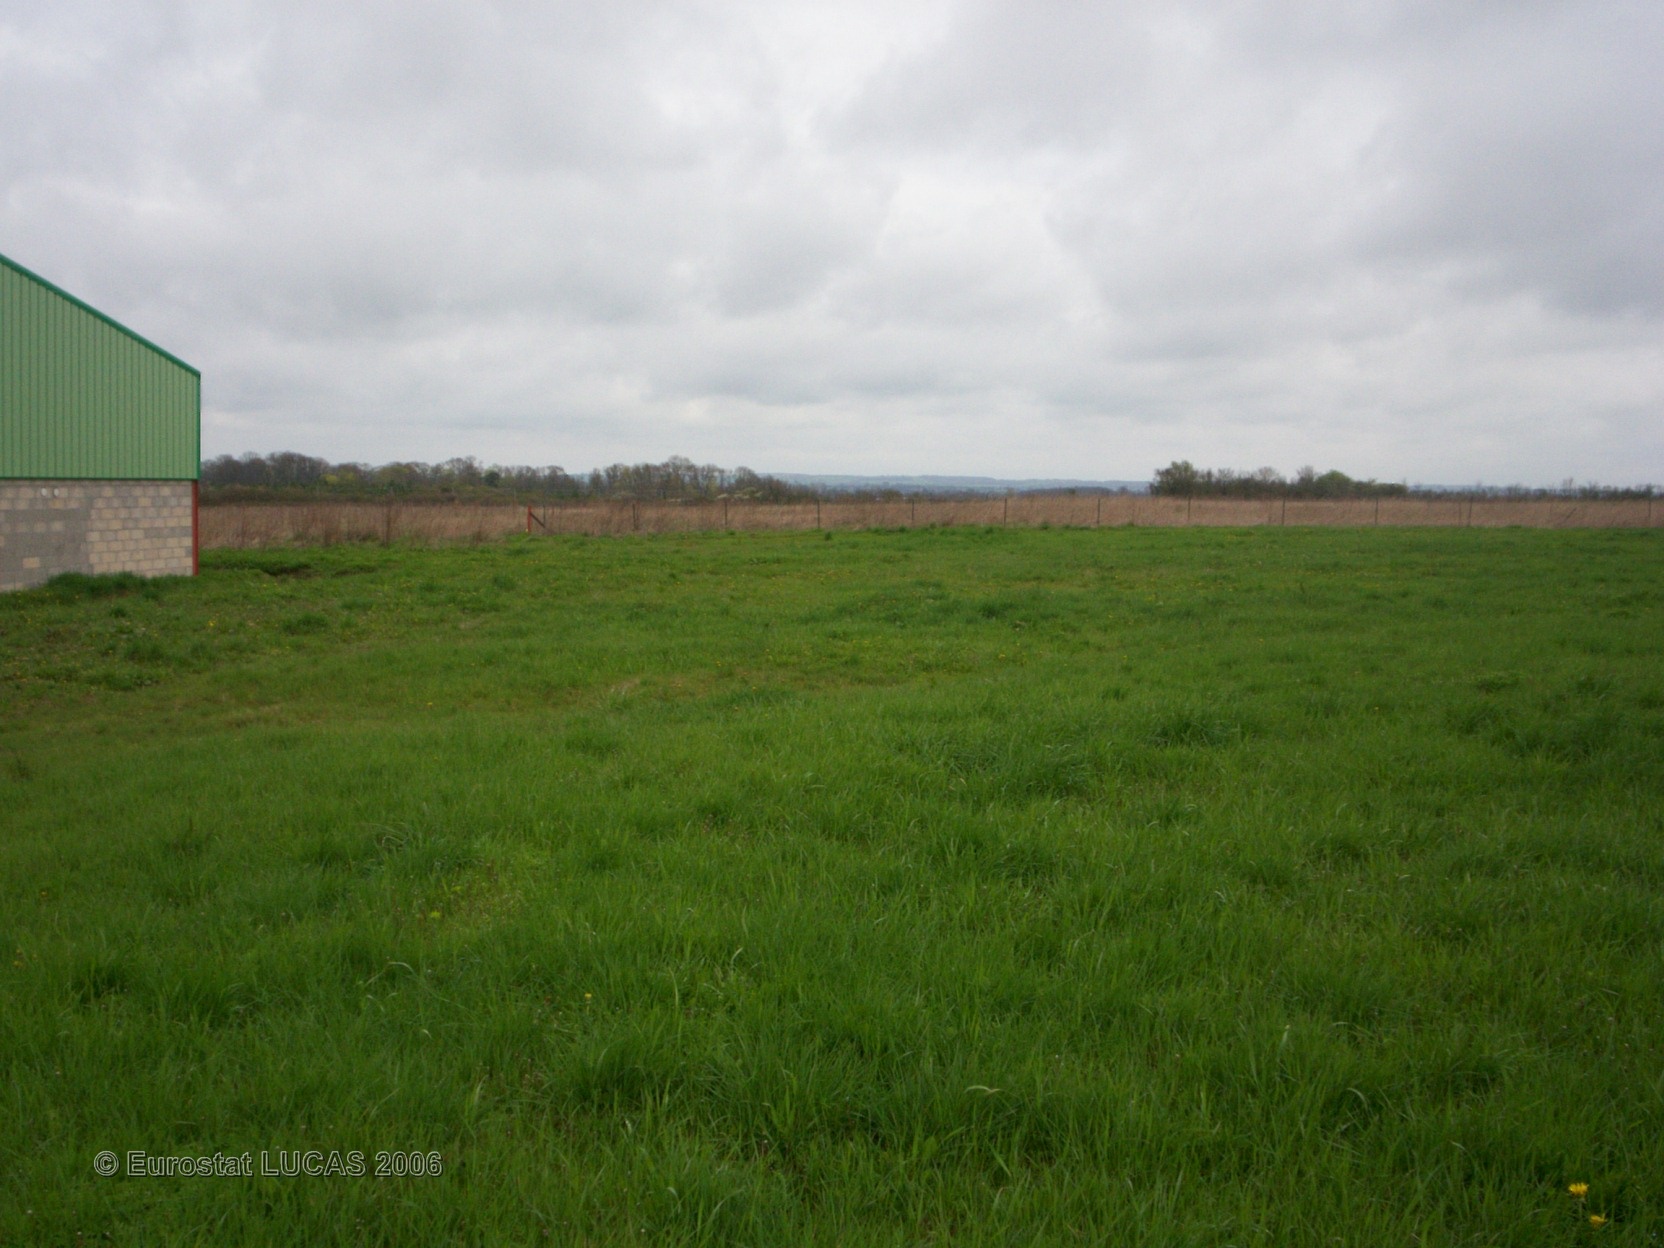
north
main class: Grassland
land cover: Grassland without tree/shrub cover
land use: Agriculture (excluding fallow land and kitchen gardens)
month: April
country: FR
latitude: 46.8160
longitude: 3.1158
